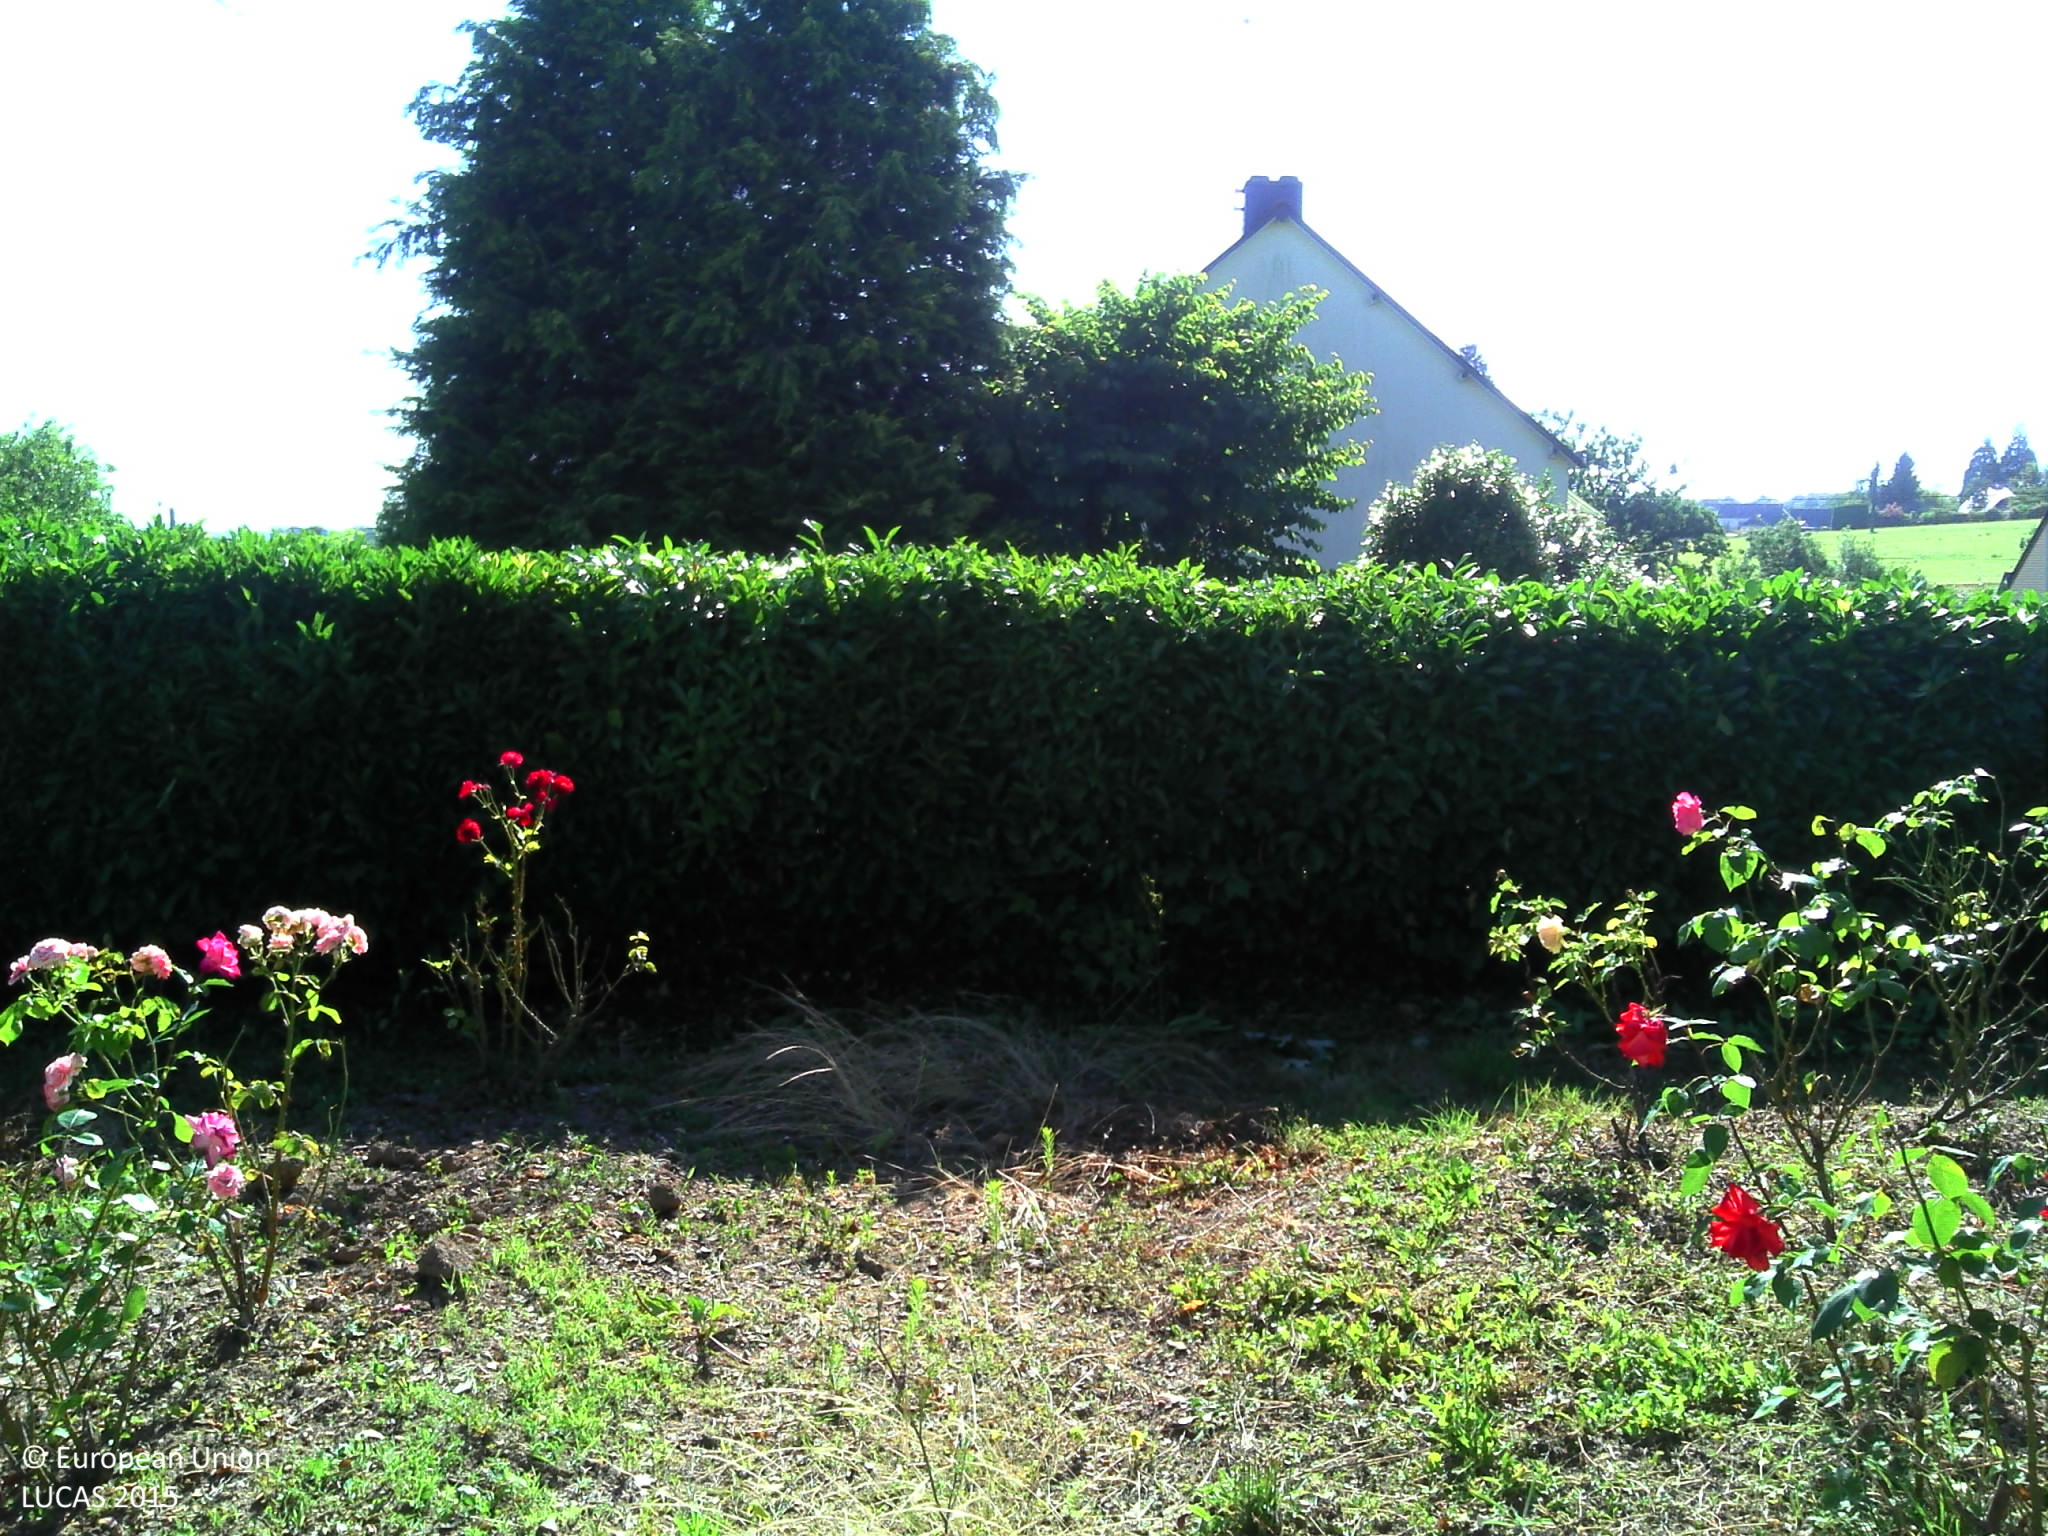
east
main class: Cropland
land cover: Floriculture and ornamental plants
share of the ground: < 10 %
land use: Kitchen garden
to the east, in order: Floriculture and ornamental plants; Artificial constructions in urban areas; Grassland with sparse tree/shrub cover; Fences; Grassland with sparse tree/shrub cover; Fences; Grassland with sparse tree/shrub cover; Artificial constructions in urban areas
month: July
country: FR
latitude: 47.6570
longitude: -1.9937
